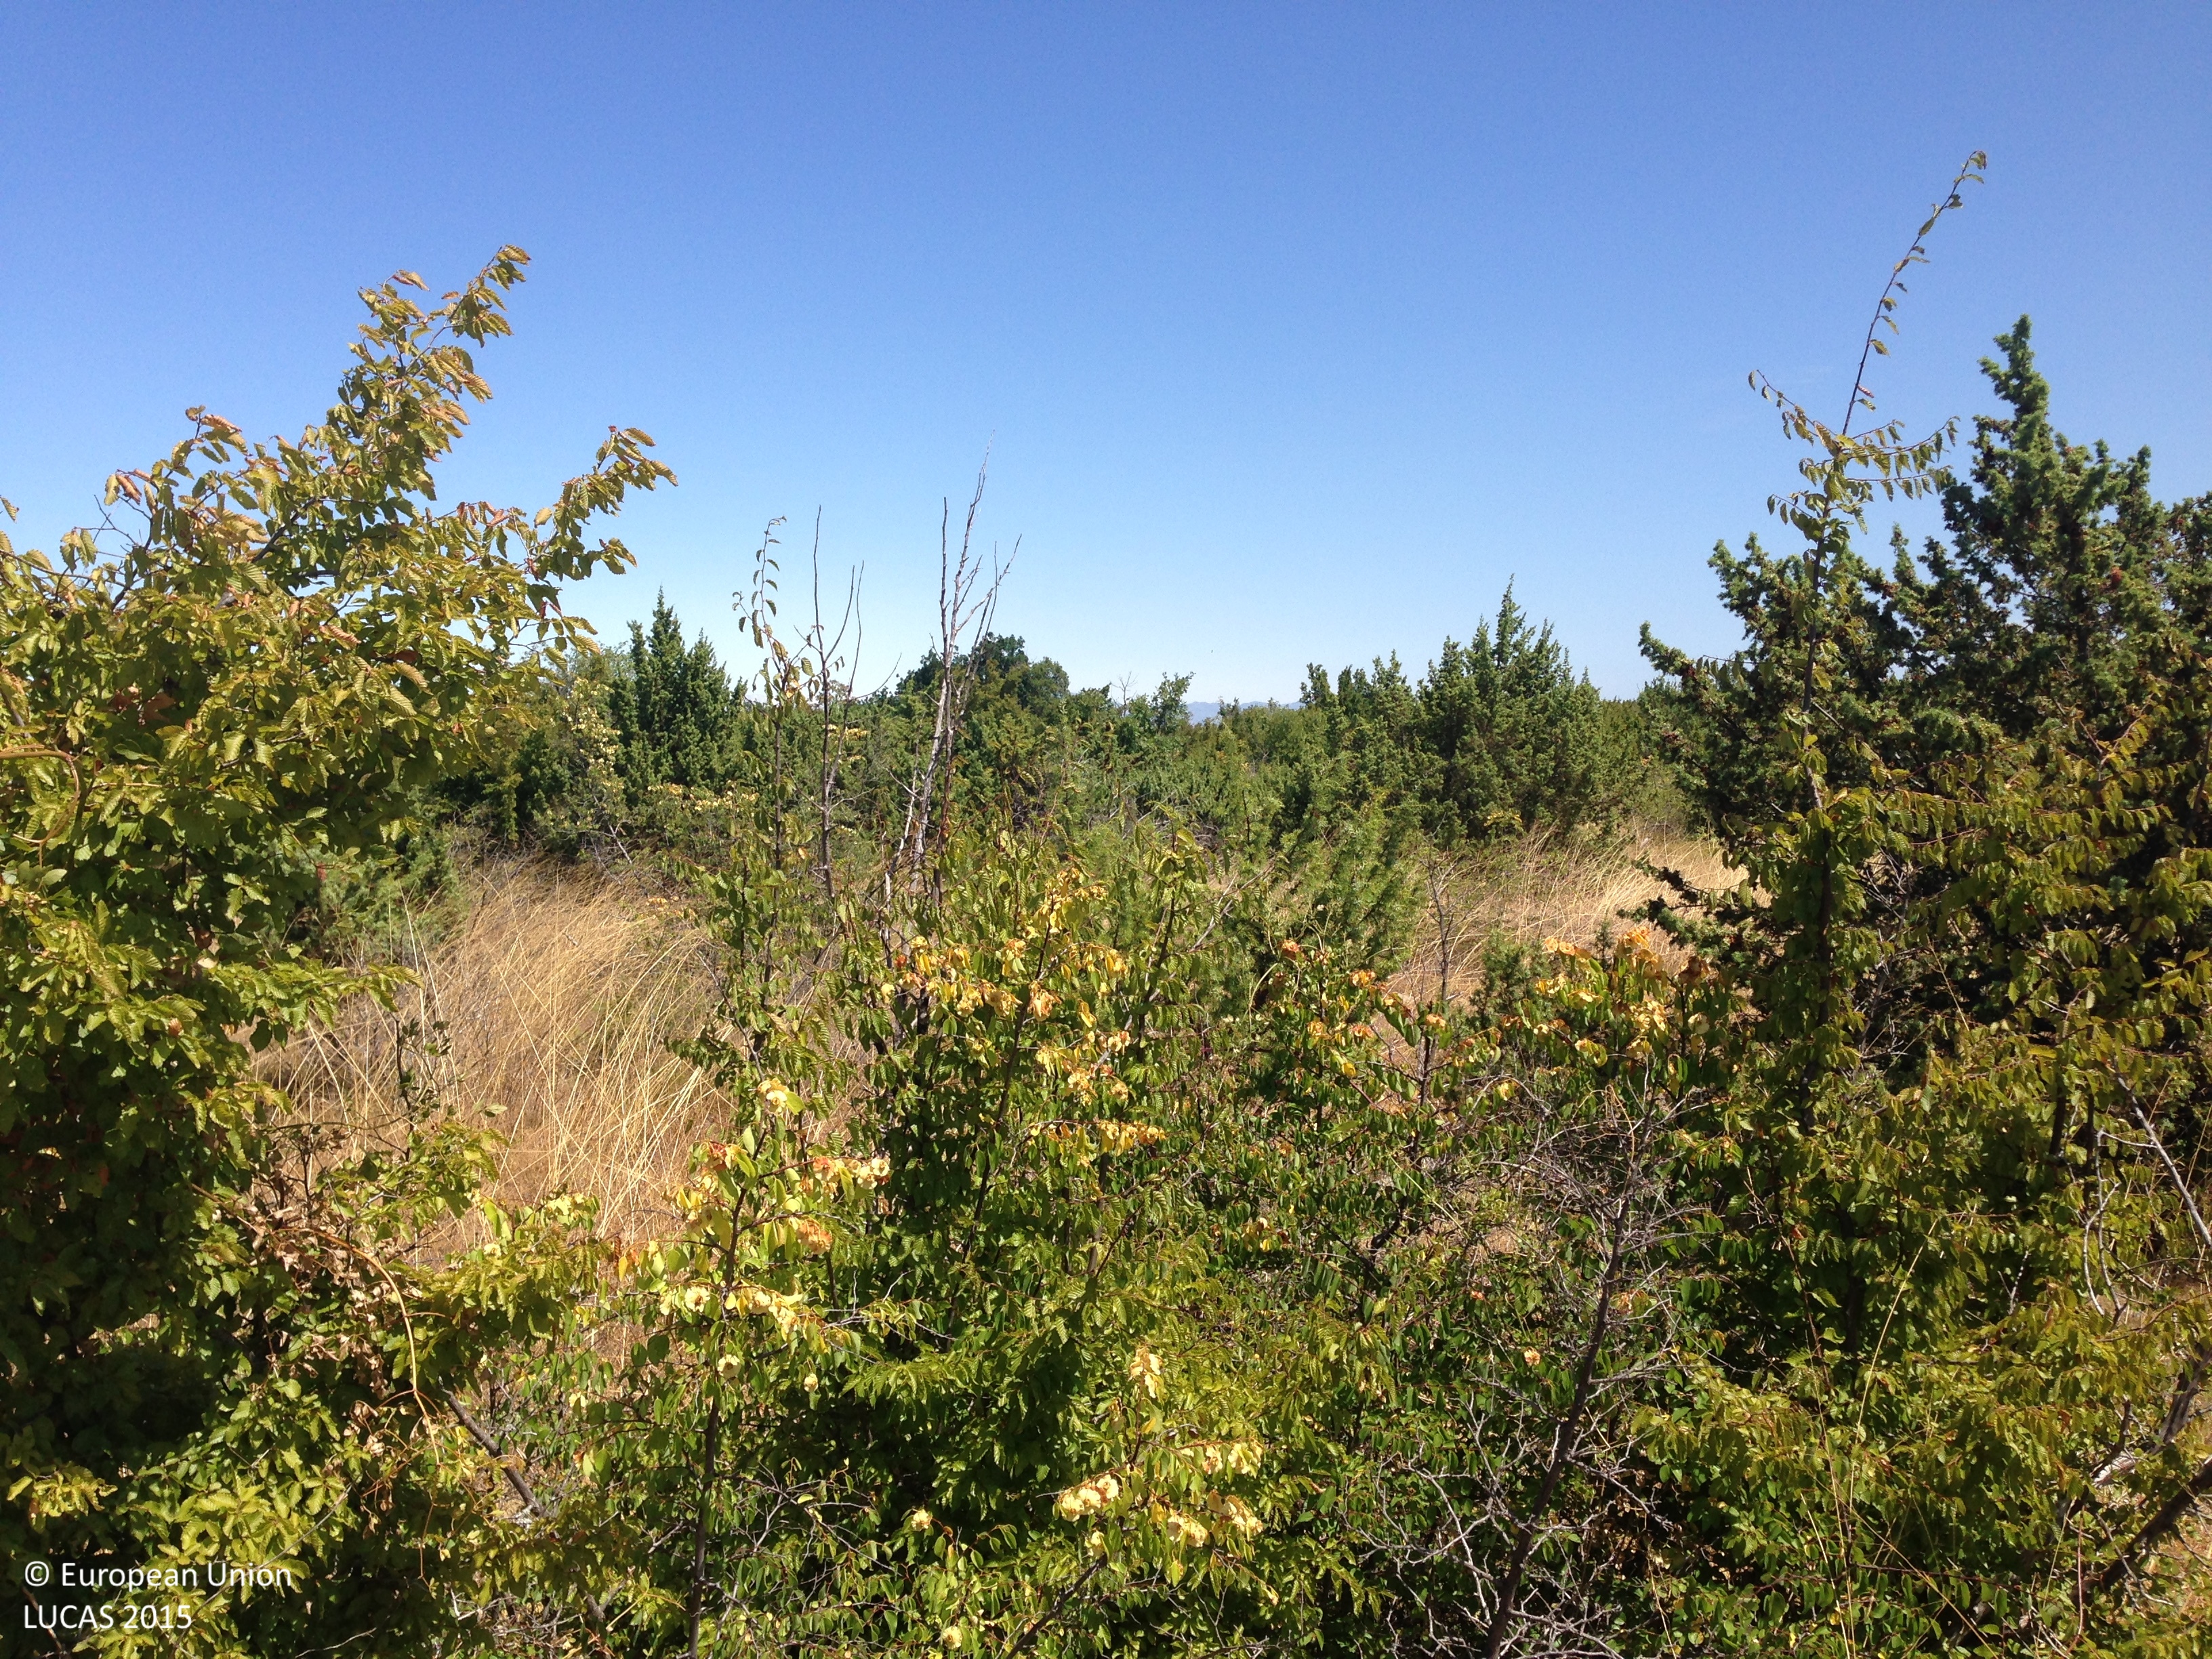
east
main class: Shrubland
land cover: Shrubland with sparse tree cover
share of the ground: > 75 %
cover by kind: shrubs 35 %, herbaceous plants 35 %, consolidated bare surface 15 %, unconsolidated bare surface 10 %, broadleaved forest trees 5 %
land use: Semi-natural and natural areas not in use
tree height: < 5 m
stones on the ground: < 10 %
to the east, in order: Shrubland with sparse tree cover; Tracks; Shrubland with sparse tree cover
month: July
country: HR
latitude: 44.0175
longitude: 15.9425
